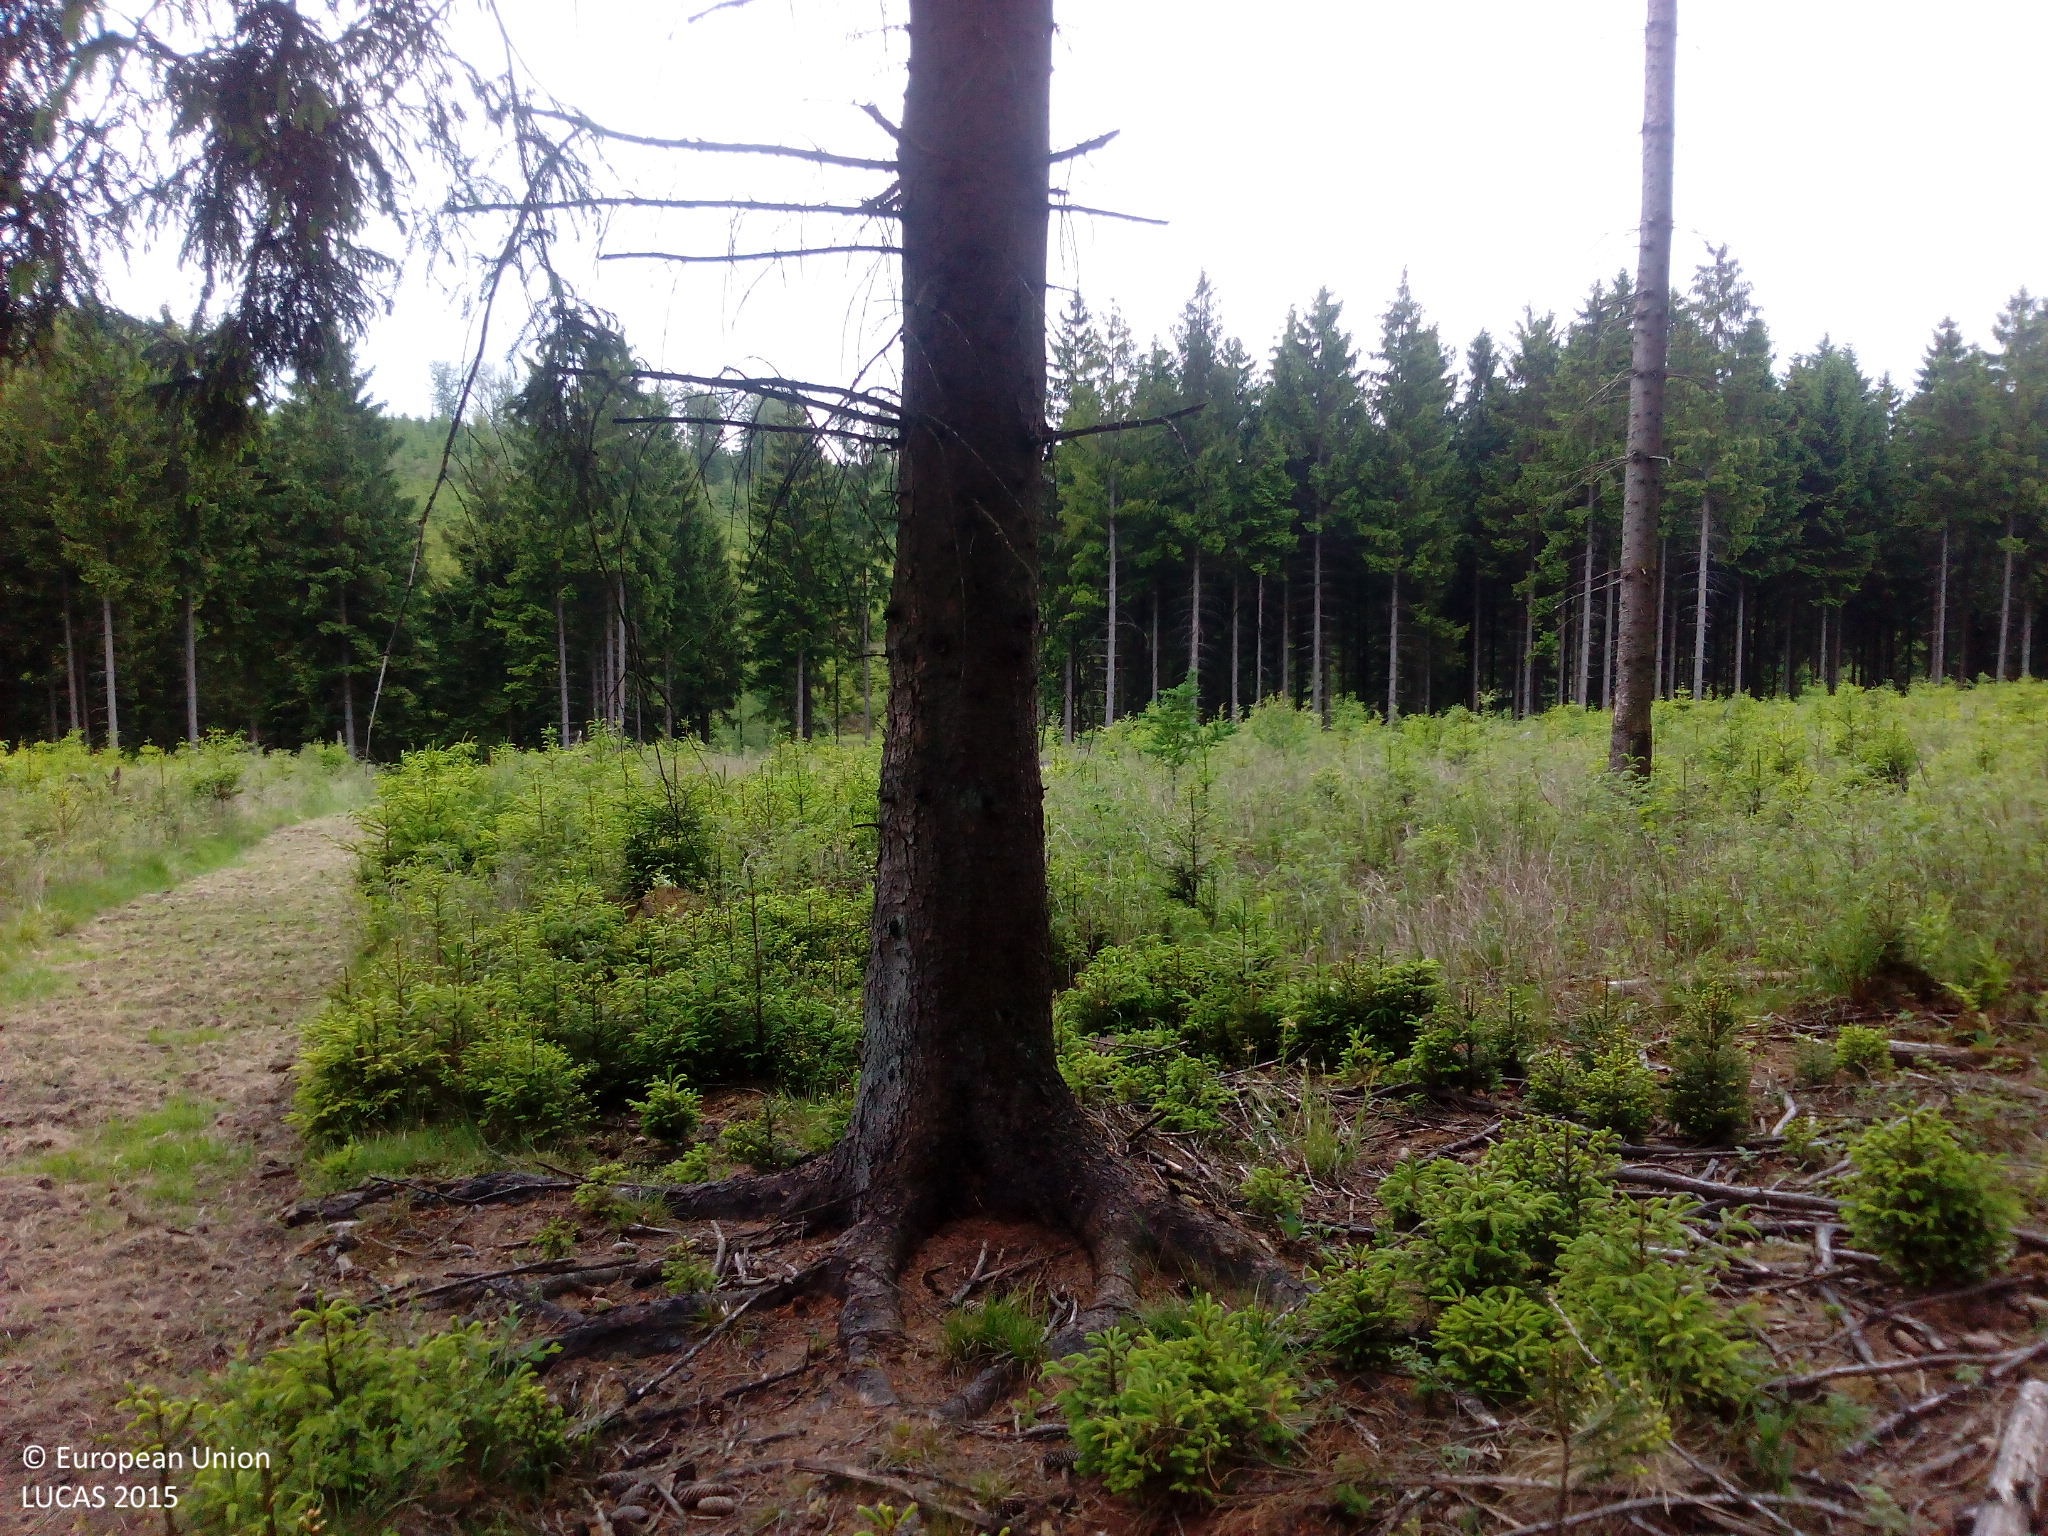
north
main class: Woodland
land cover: Spruce dominated coniferous woodland
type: hemiboreal forest and nemoral coniferous forest and mixed broadleaved-coniferous forest
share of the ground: > 75 %
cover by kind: coniferous forest trees 50 %, shrubs 50 %
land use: Forestry
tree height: > 5 m
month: June
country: DE
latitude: 51.4143
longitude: 8.4331
